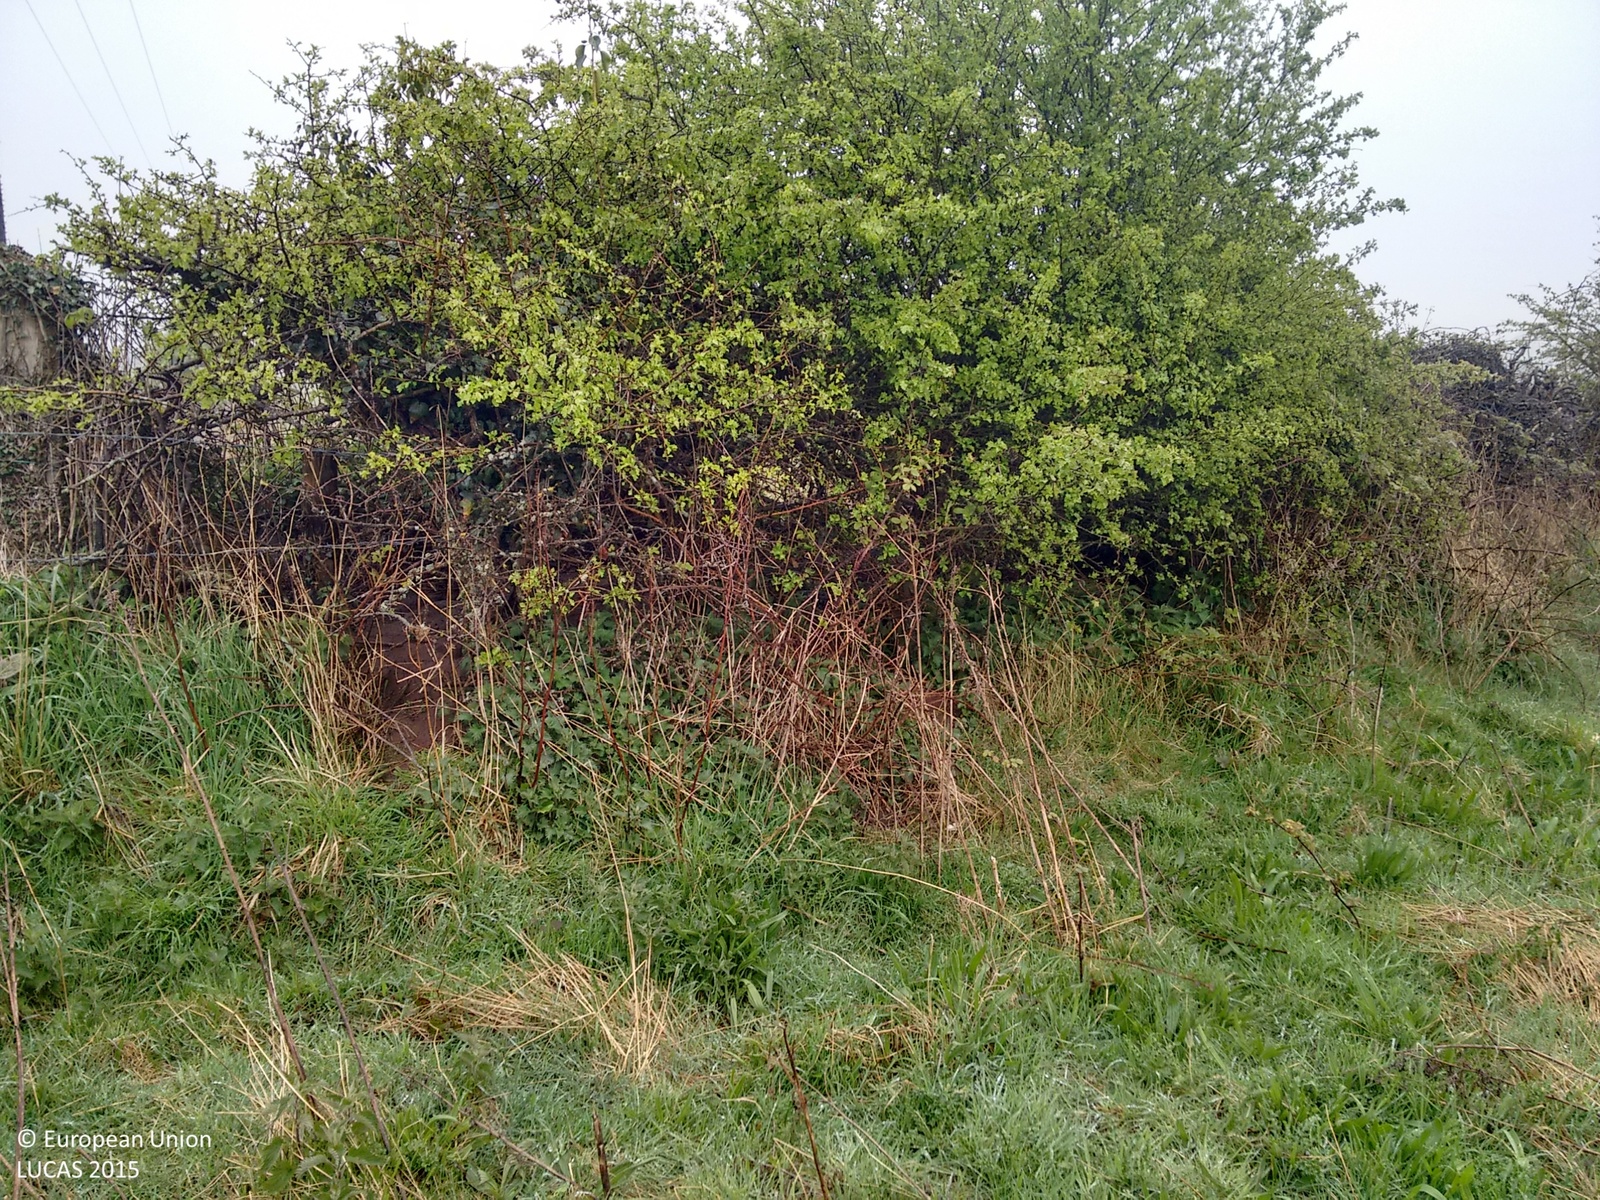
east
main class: Grassland
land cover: Grassland without tree/shrub cover
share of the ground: > 75 %
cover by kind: herbaceous plants 100 %
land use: Agriculture (excluding fallow land and kitchen gardens)
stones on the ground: < 10 %
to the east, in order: Grassland without tree/shrub cover; Fences; Managed hedges; Tracks; Grass margins; Fences; Grassland without tree/shrub cover
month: May
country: GB
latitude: 55.1641
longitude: -1.6491
